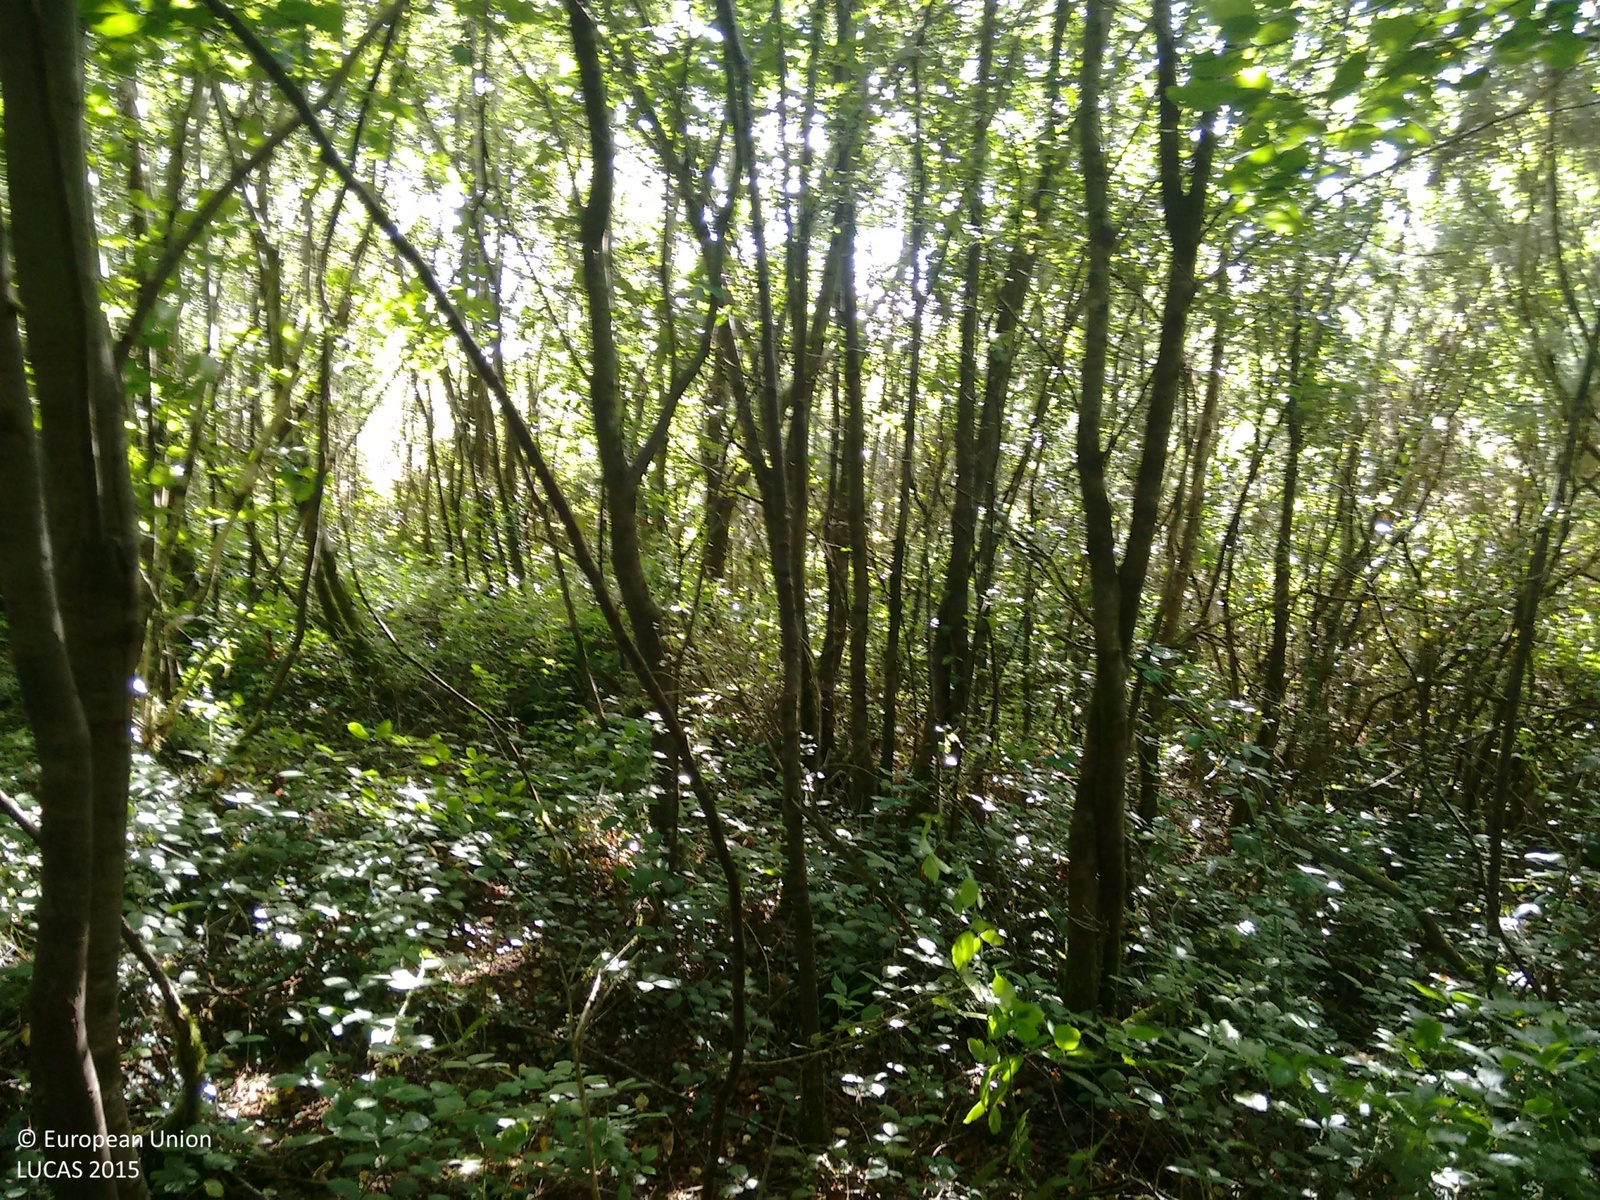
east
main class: Woodland
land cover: Broadleaved woodland
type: acidophilous oak and oak-birch forest
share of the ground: > 75 %
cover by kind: broadleaved forest trees 100 %
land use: Semi-natural and natural areas not in use
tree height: > 5 m
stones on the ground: < 10 %
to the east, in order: Broadleaved woodland; Tracks; Broadleaved woodland; Ditches and canals; Broadleaved woodland; Artificial constructions; Broadleaved woodland; Tracks; Broadleaved woodland
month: August
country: IE
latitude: 51.8957
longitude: -9.5479
